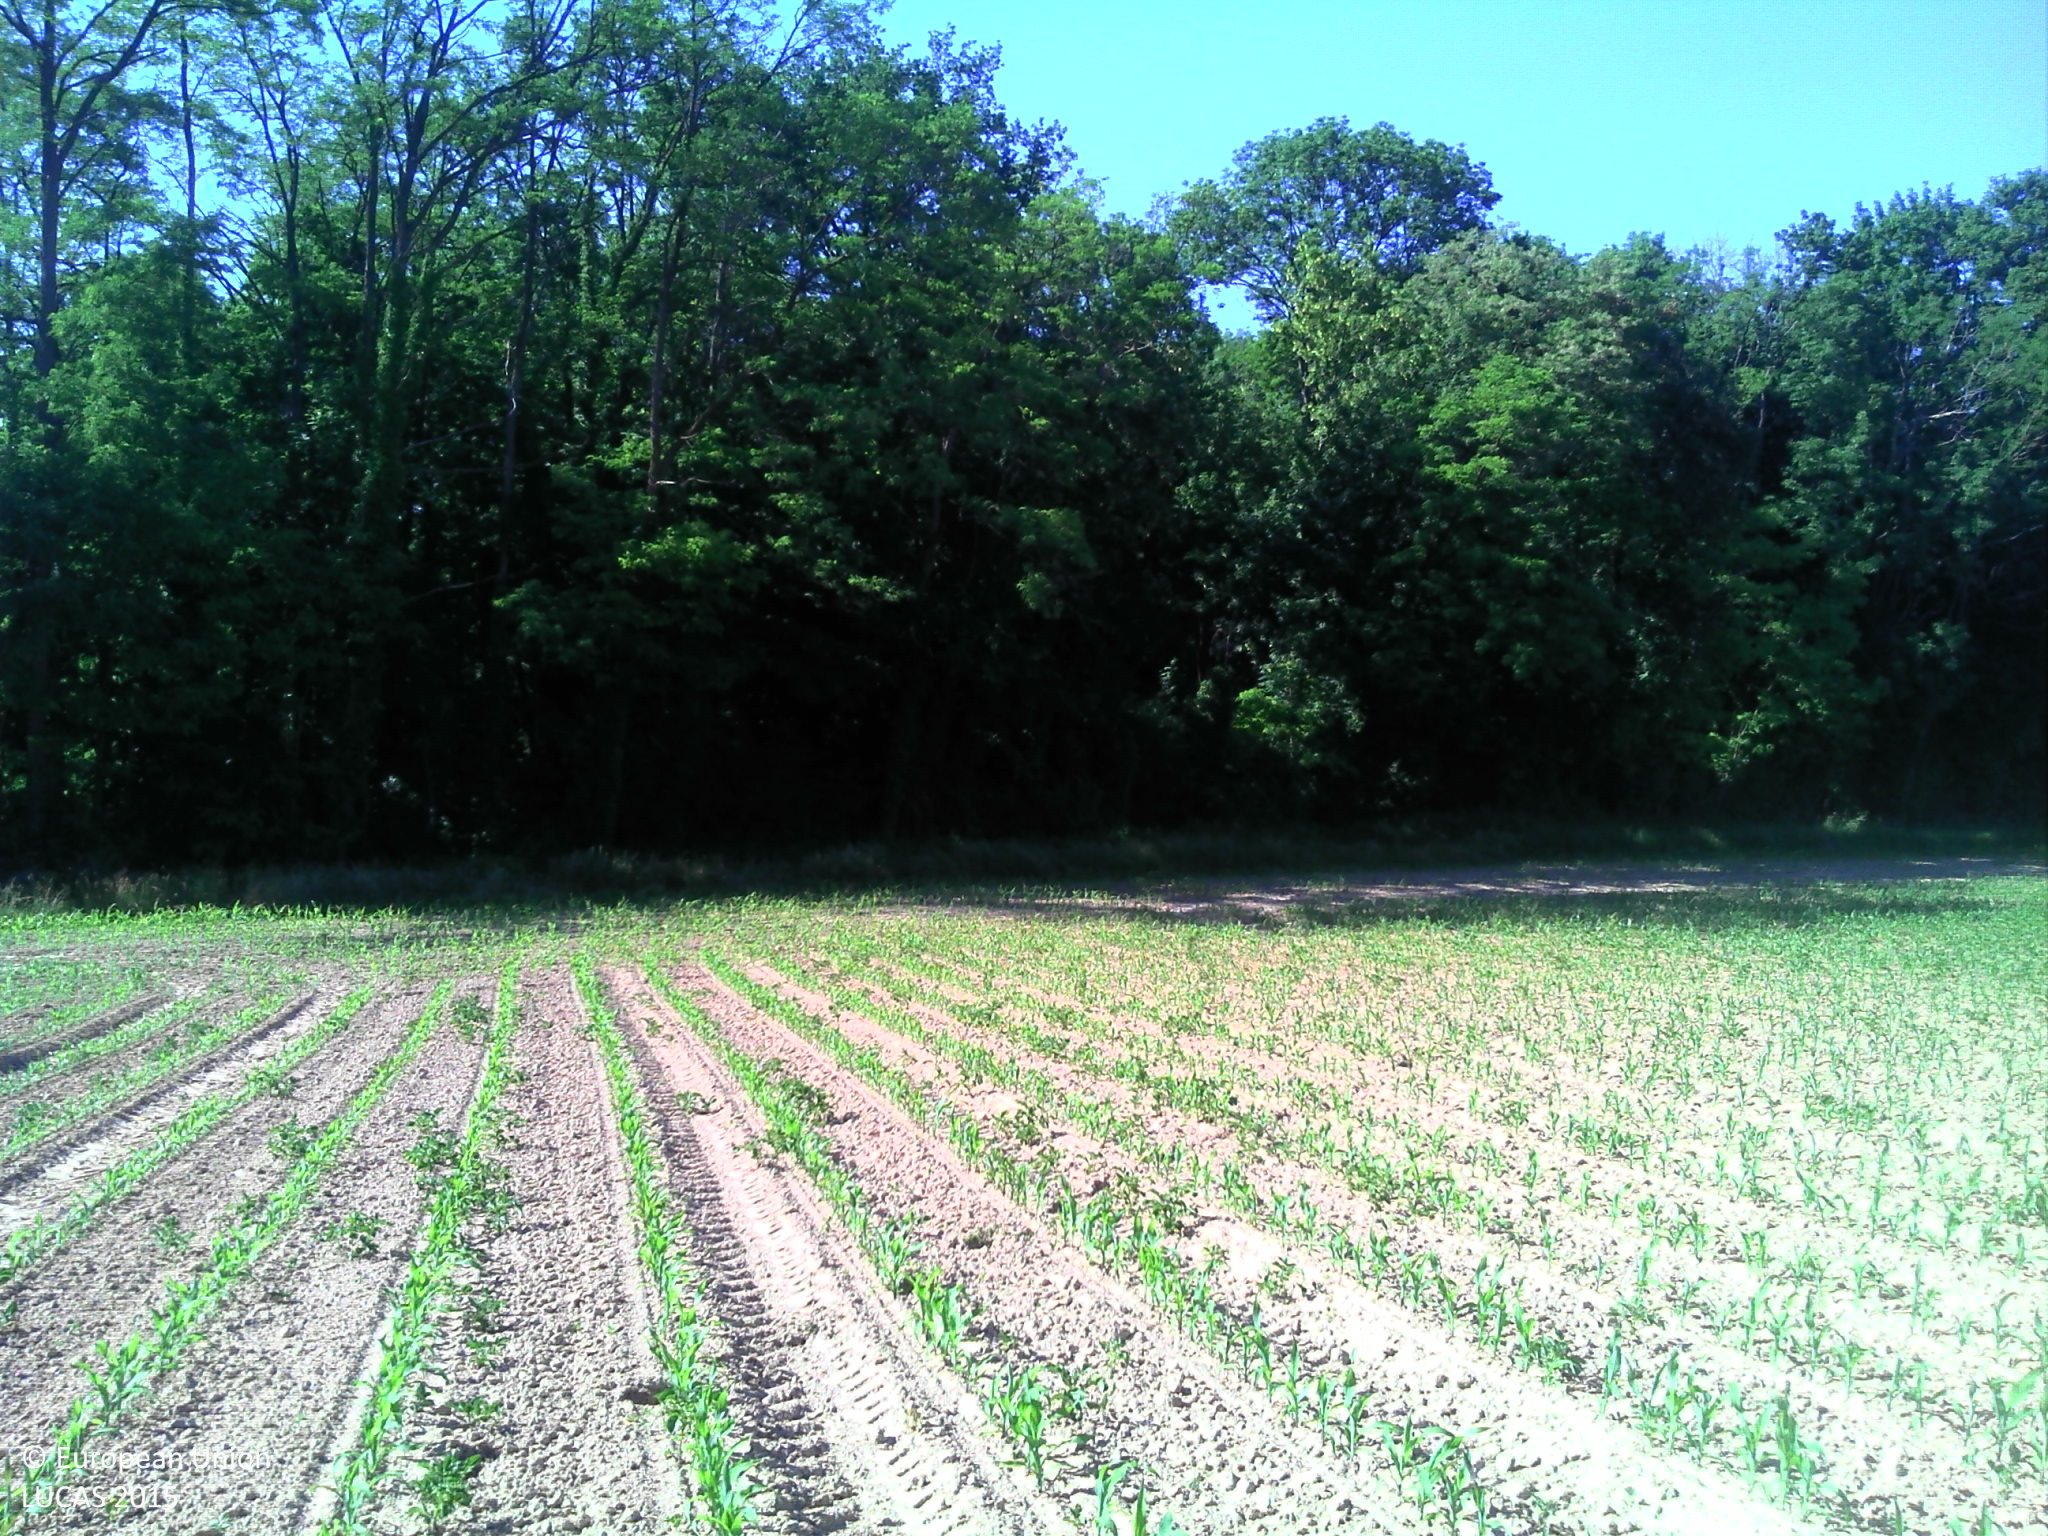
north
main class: Cropland
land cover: Maize
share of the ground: 10 - 25 %
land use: Agriculture (excluding fallow land and kitchen gardens)
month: June
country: FR
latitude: 47.6708
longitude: 7.4045
